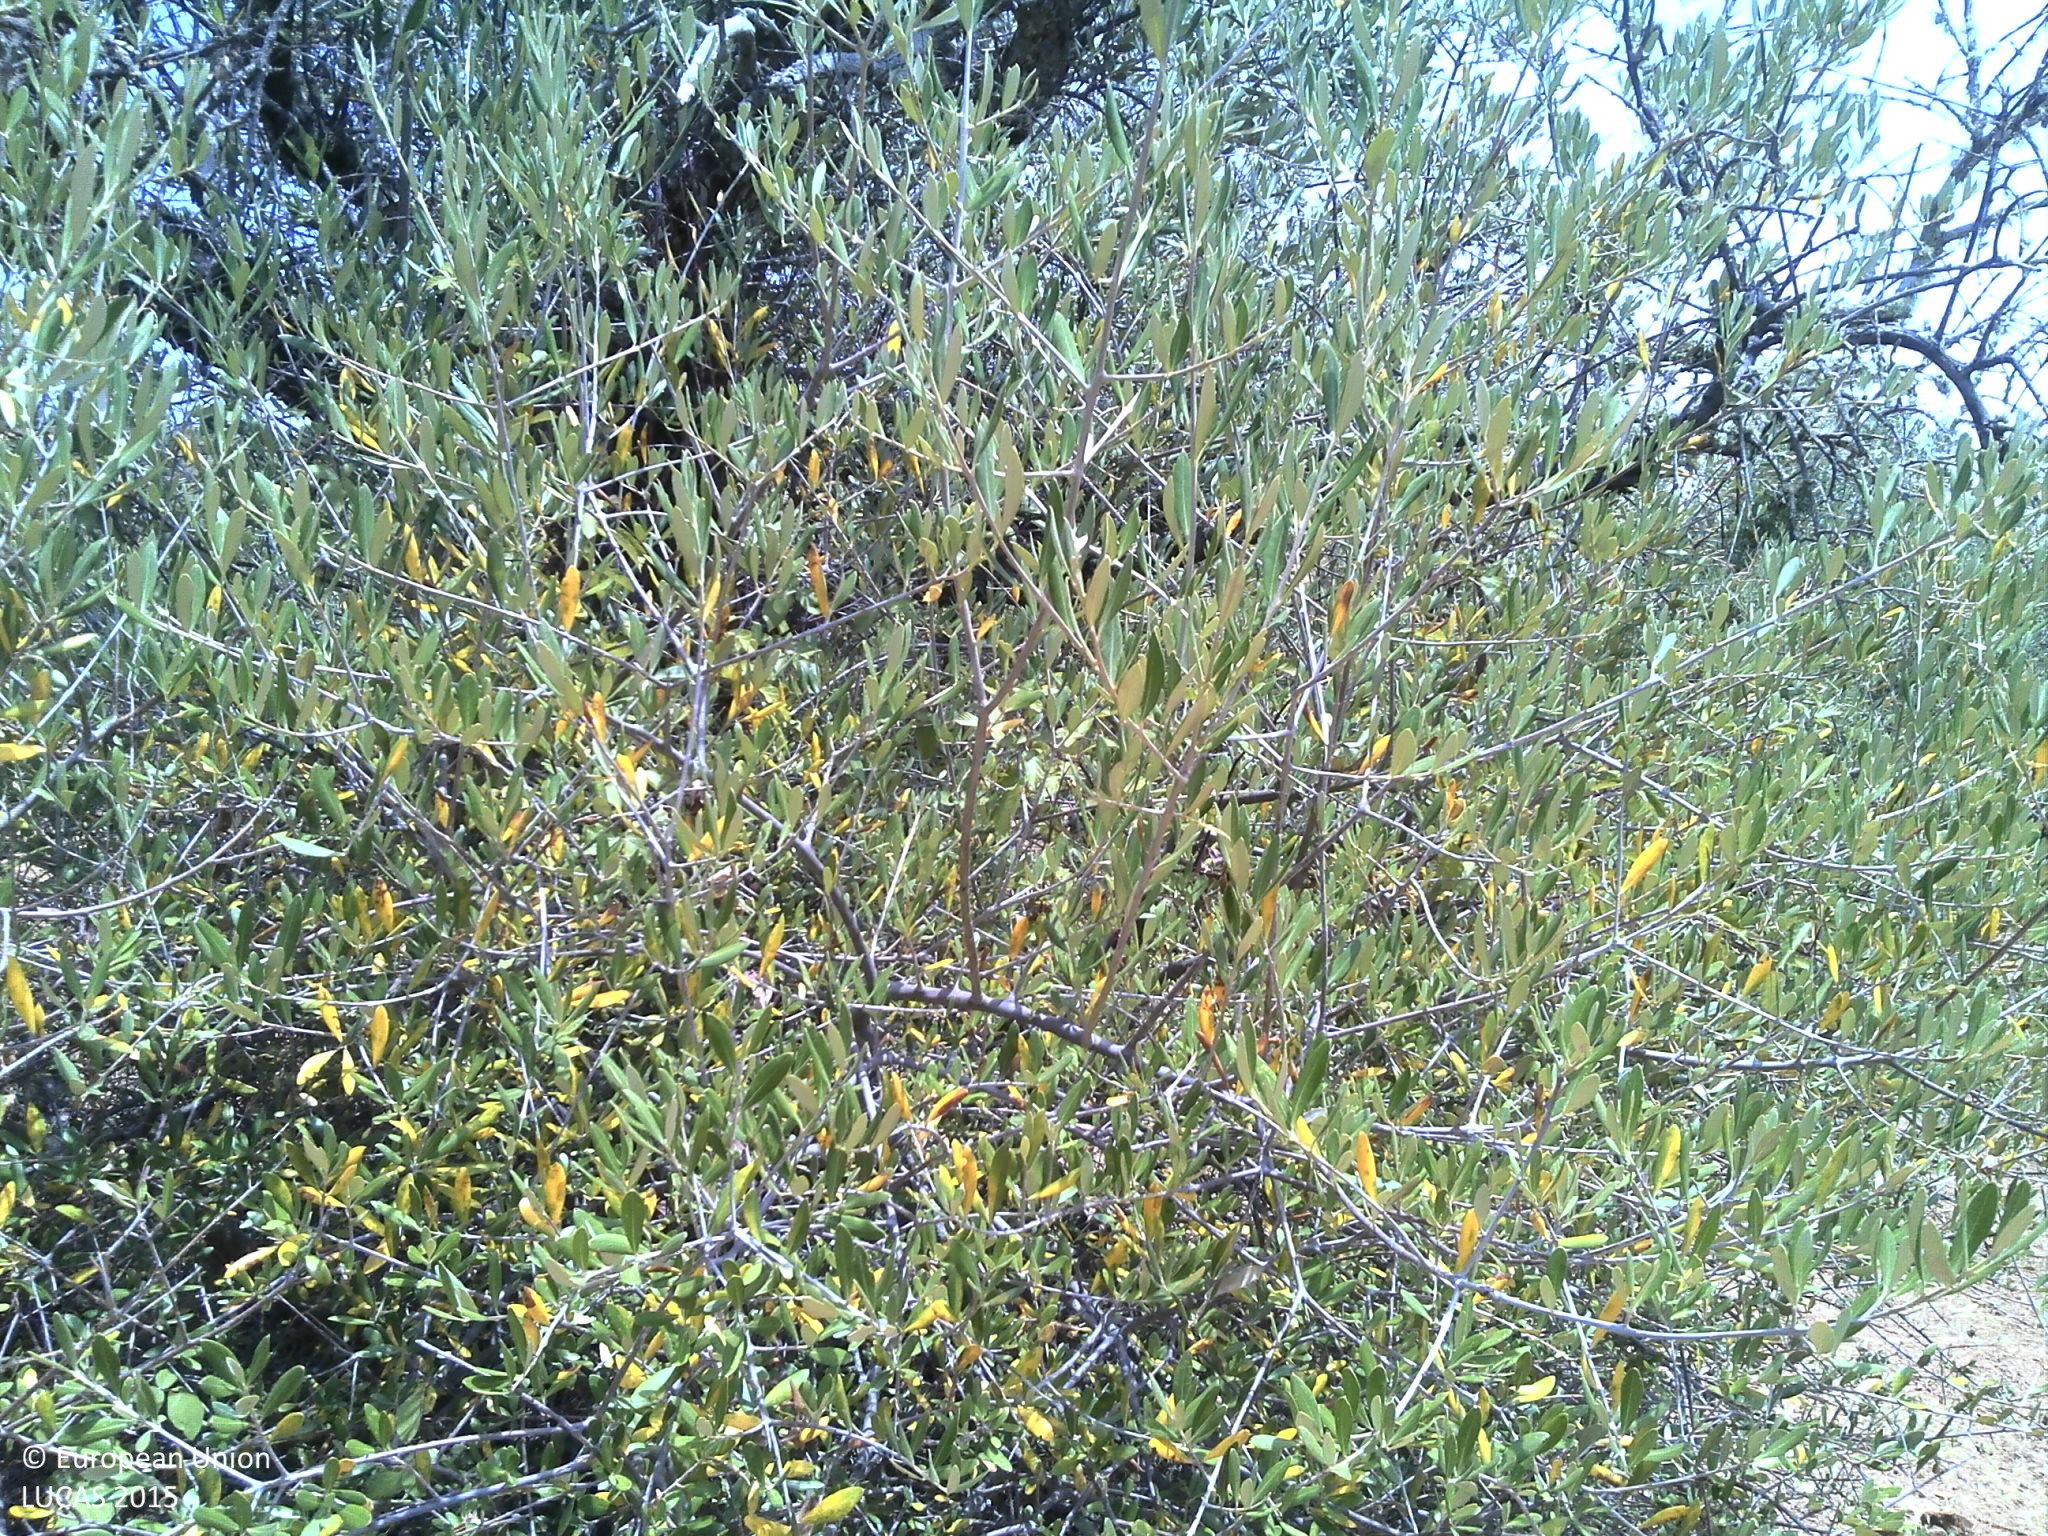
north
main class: Cropland
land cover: Olive groves
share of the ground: 25 - 50 %
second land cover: Grassland without tree/shrub cover
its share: 25 - 50 %
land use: Agriculture (excluding fallow land and kitchen gardens)
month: July
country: PT
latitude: 38.2231
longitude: -7.6754
